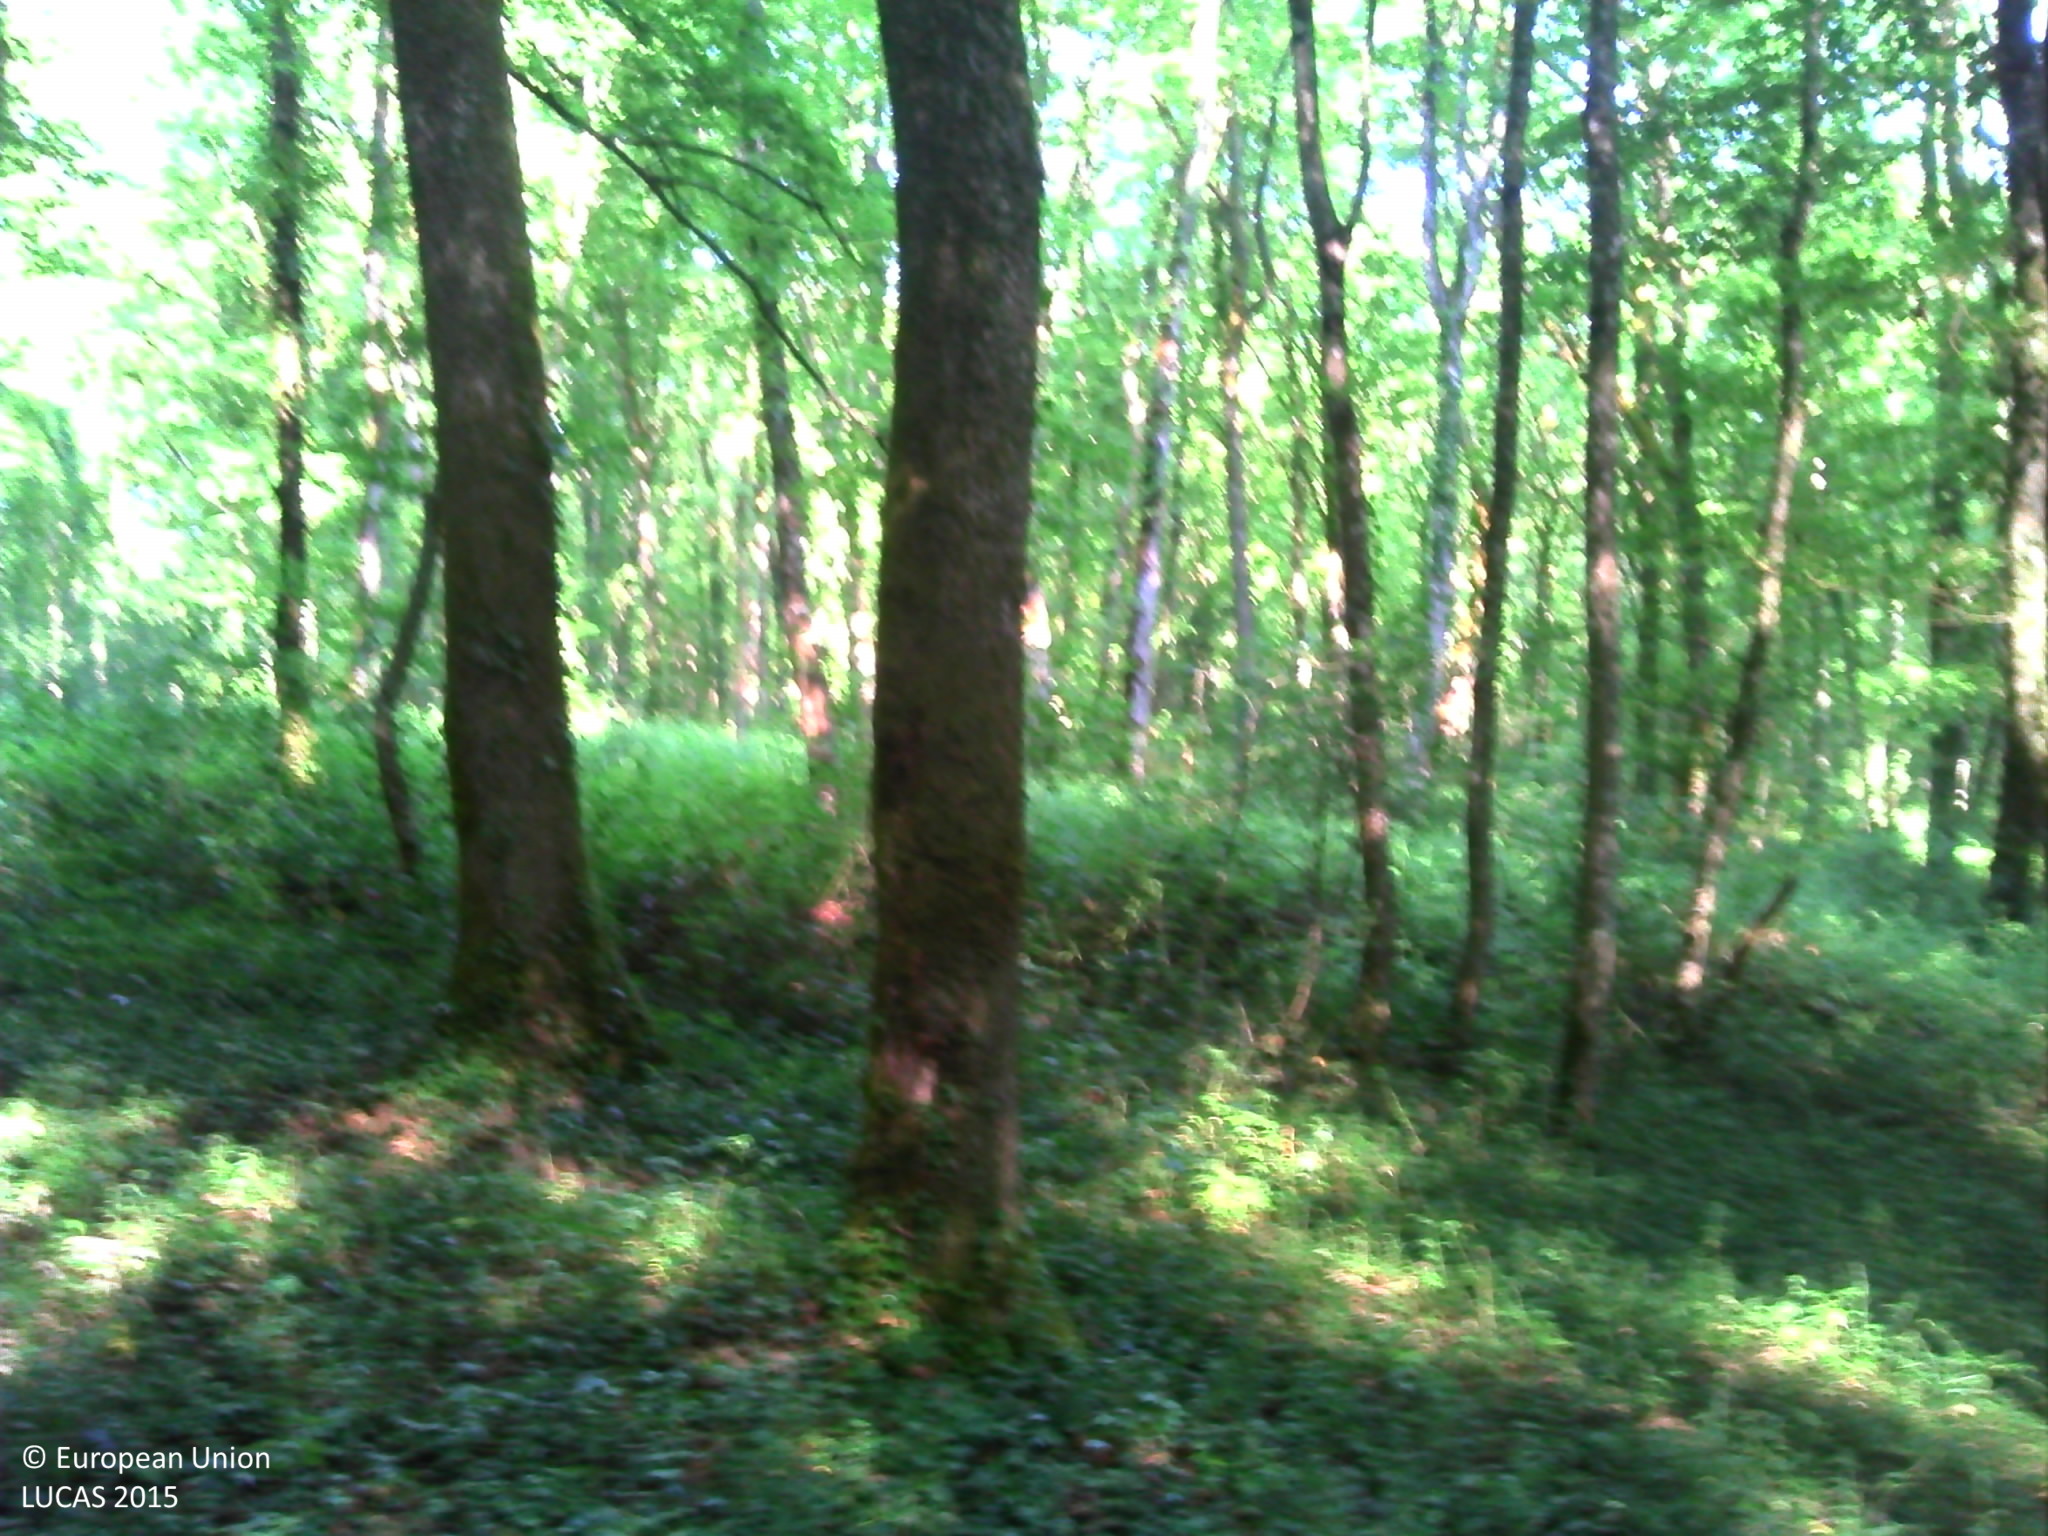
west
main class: Woodland
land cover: Broadleaved woodland
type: beech forest
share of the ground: > 75 %
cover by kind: broadleaved forest trees 95 %, herbaceous plants 5 %
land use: Forestry
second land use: Sport
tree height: > 5 m
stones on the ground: < 10 %
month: June
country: FR
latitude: 47.5981
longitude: 6.1576
